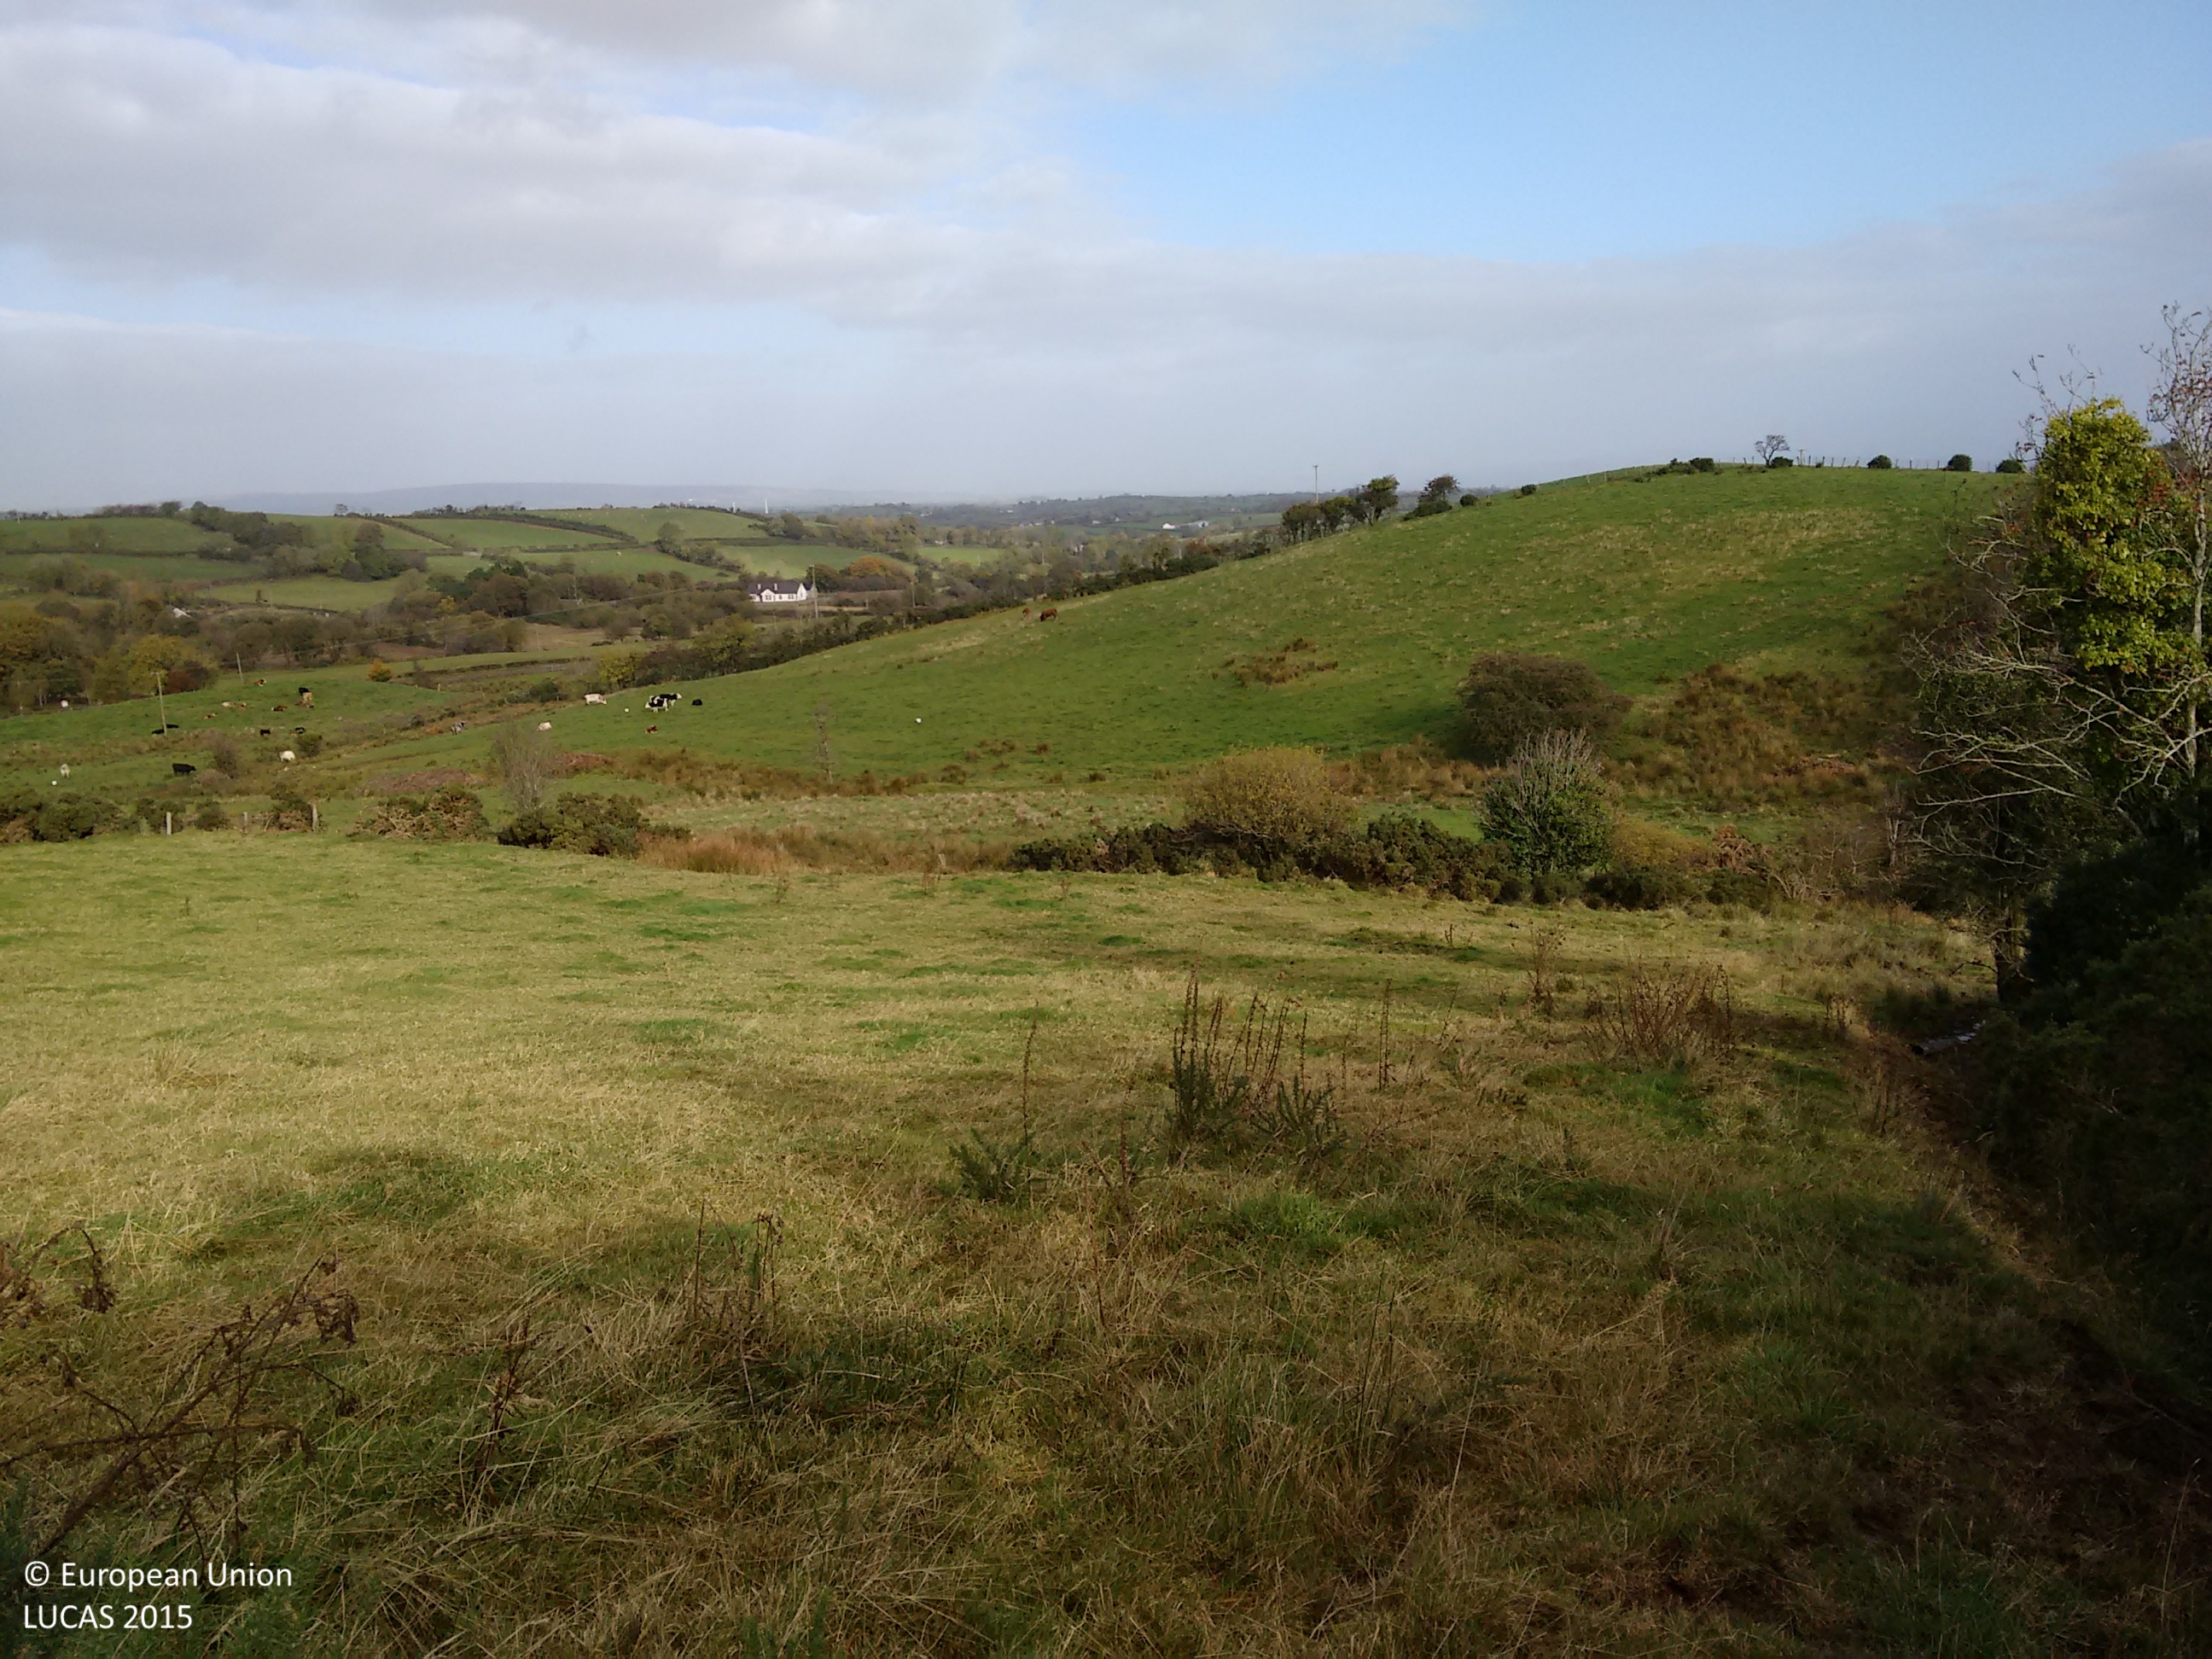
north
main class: Grassland
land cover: Grassland without tree/shrub cover
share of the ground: > 75 %
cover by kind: herbaceous plants 100 %
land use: Agriculture (excluding fallow land and kitchen gardens)
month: October
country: GB
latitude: 54.4526
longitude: -7.3800
